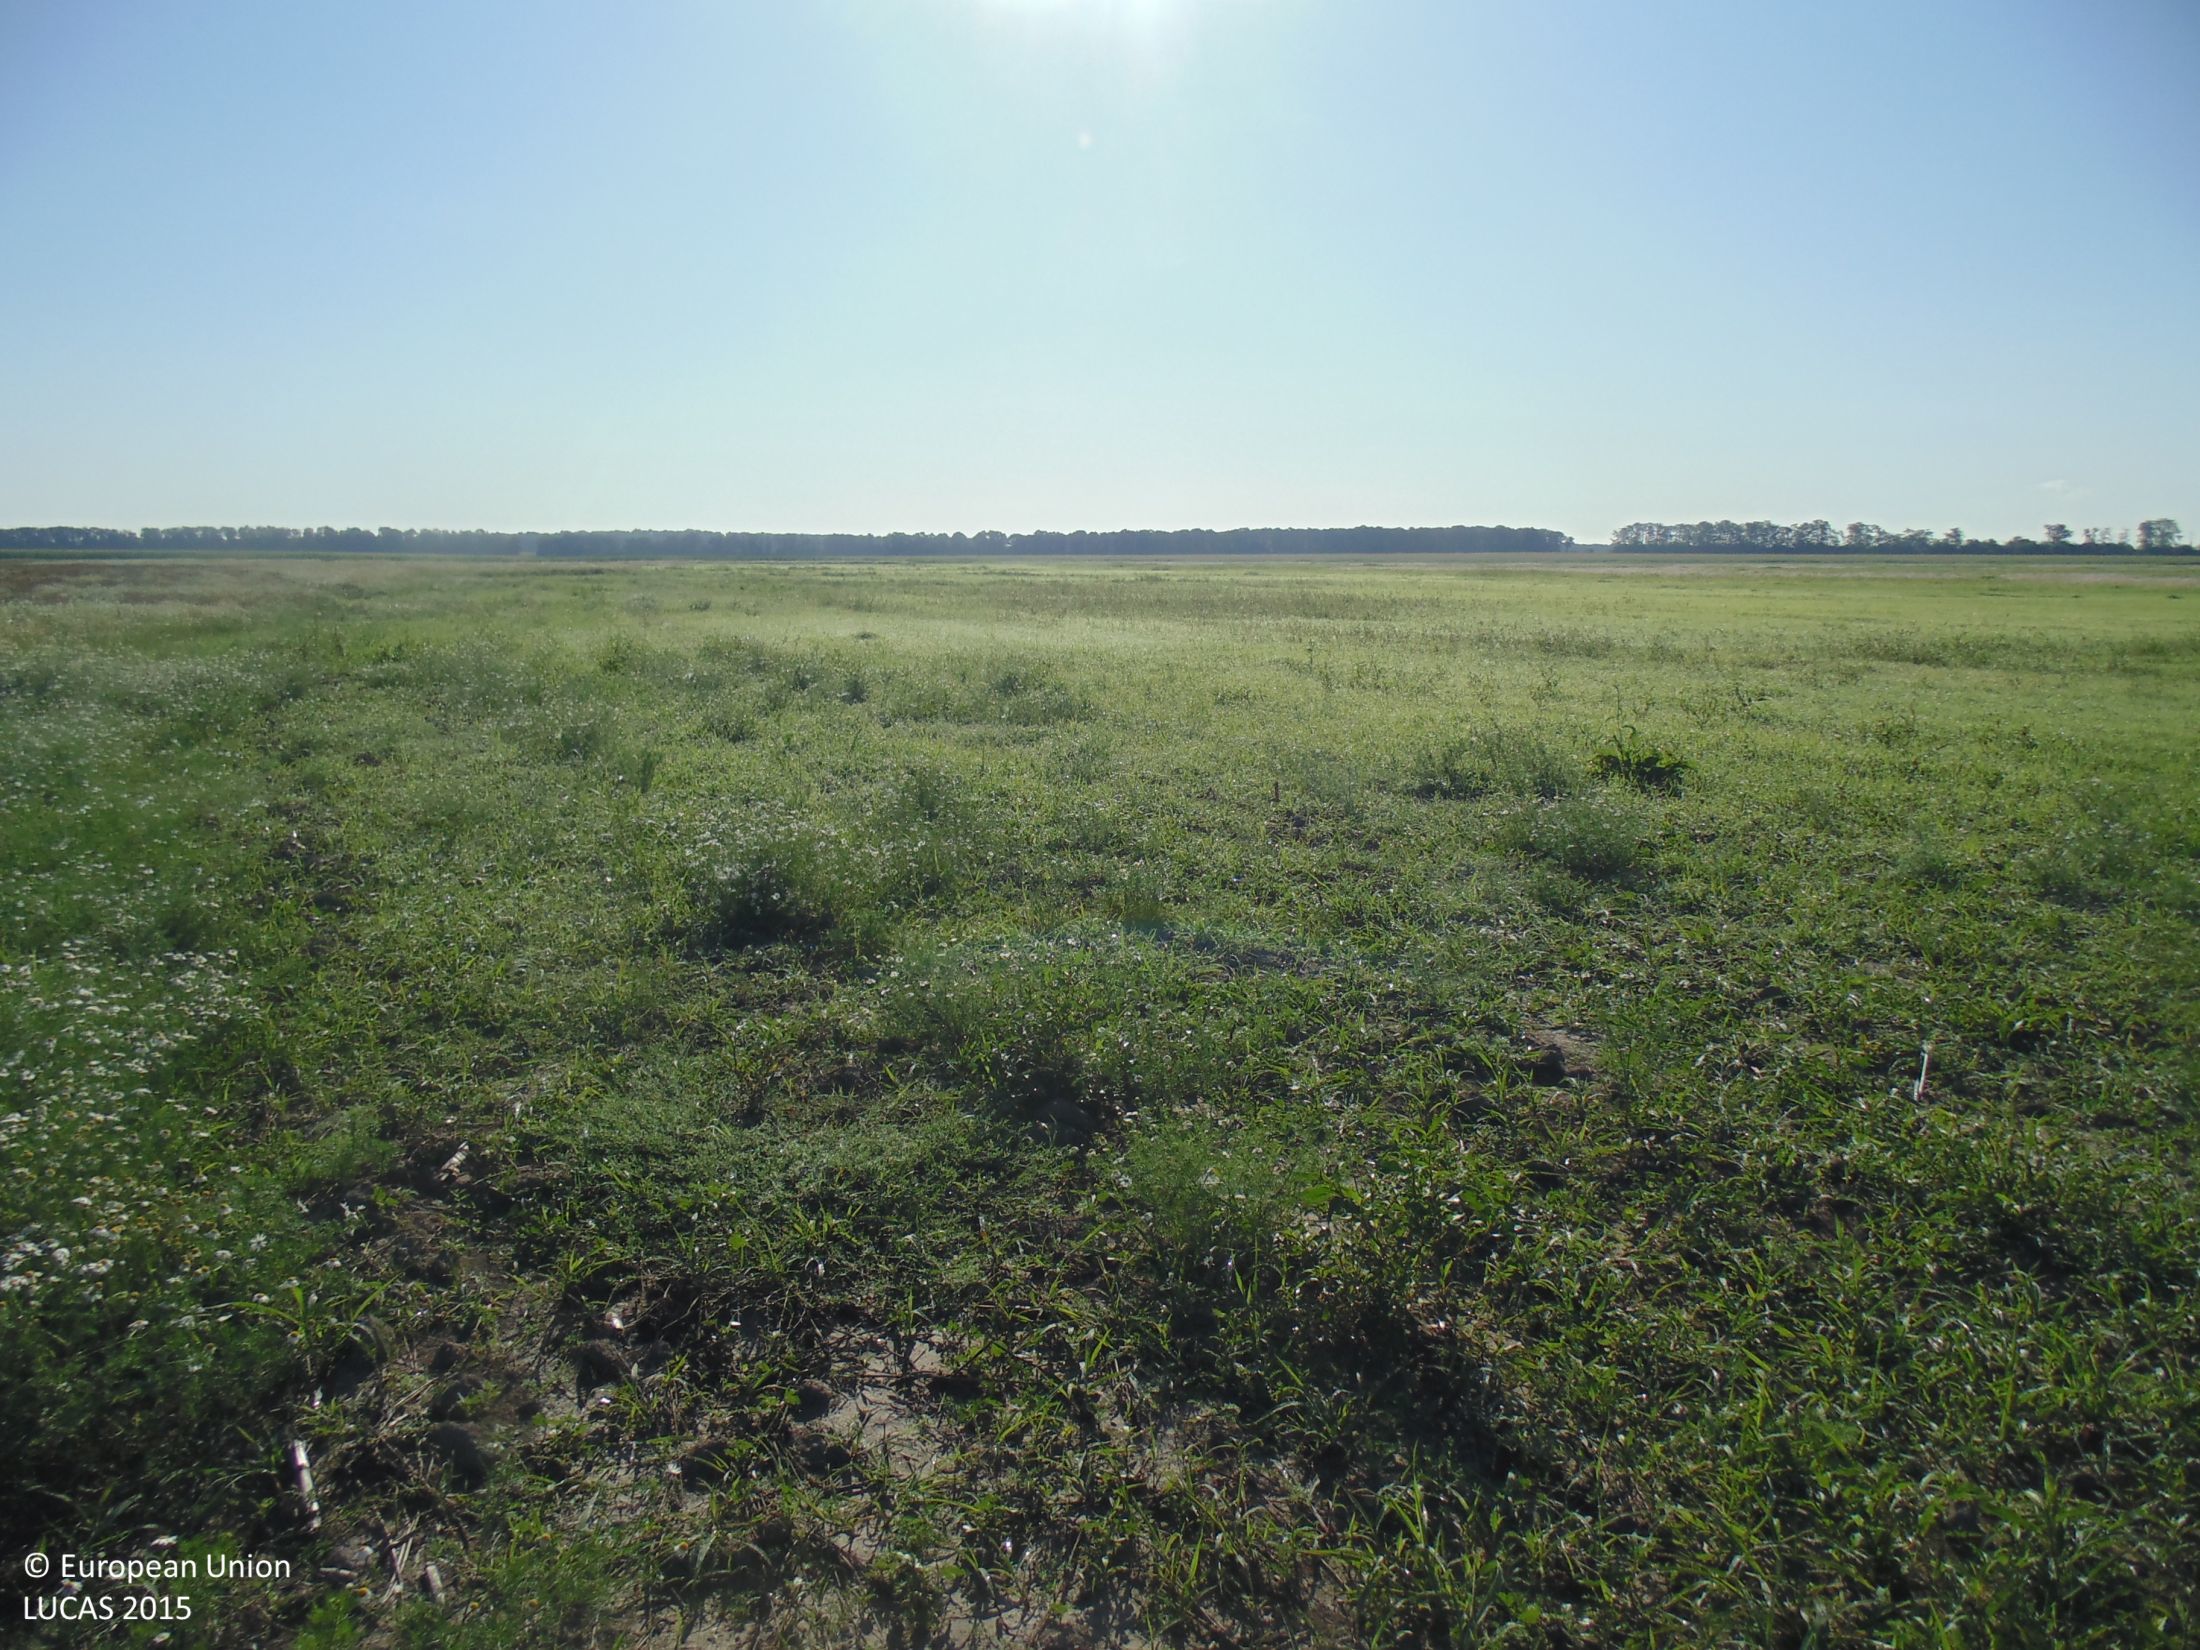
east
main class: Grassland
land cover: Spontaneously vegetated surfaces
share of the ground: > 75 %
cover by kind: herbaceous plants 80 %, unconsolidated bare surface 20 %
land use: Fallow land
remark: Temporary dry
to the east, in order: Spontaneously vegetated surfaces; Inland marshes
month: July
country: BG
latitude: 43.4867
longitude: 27.9619
